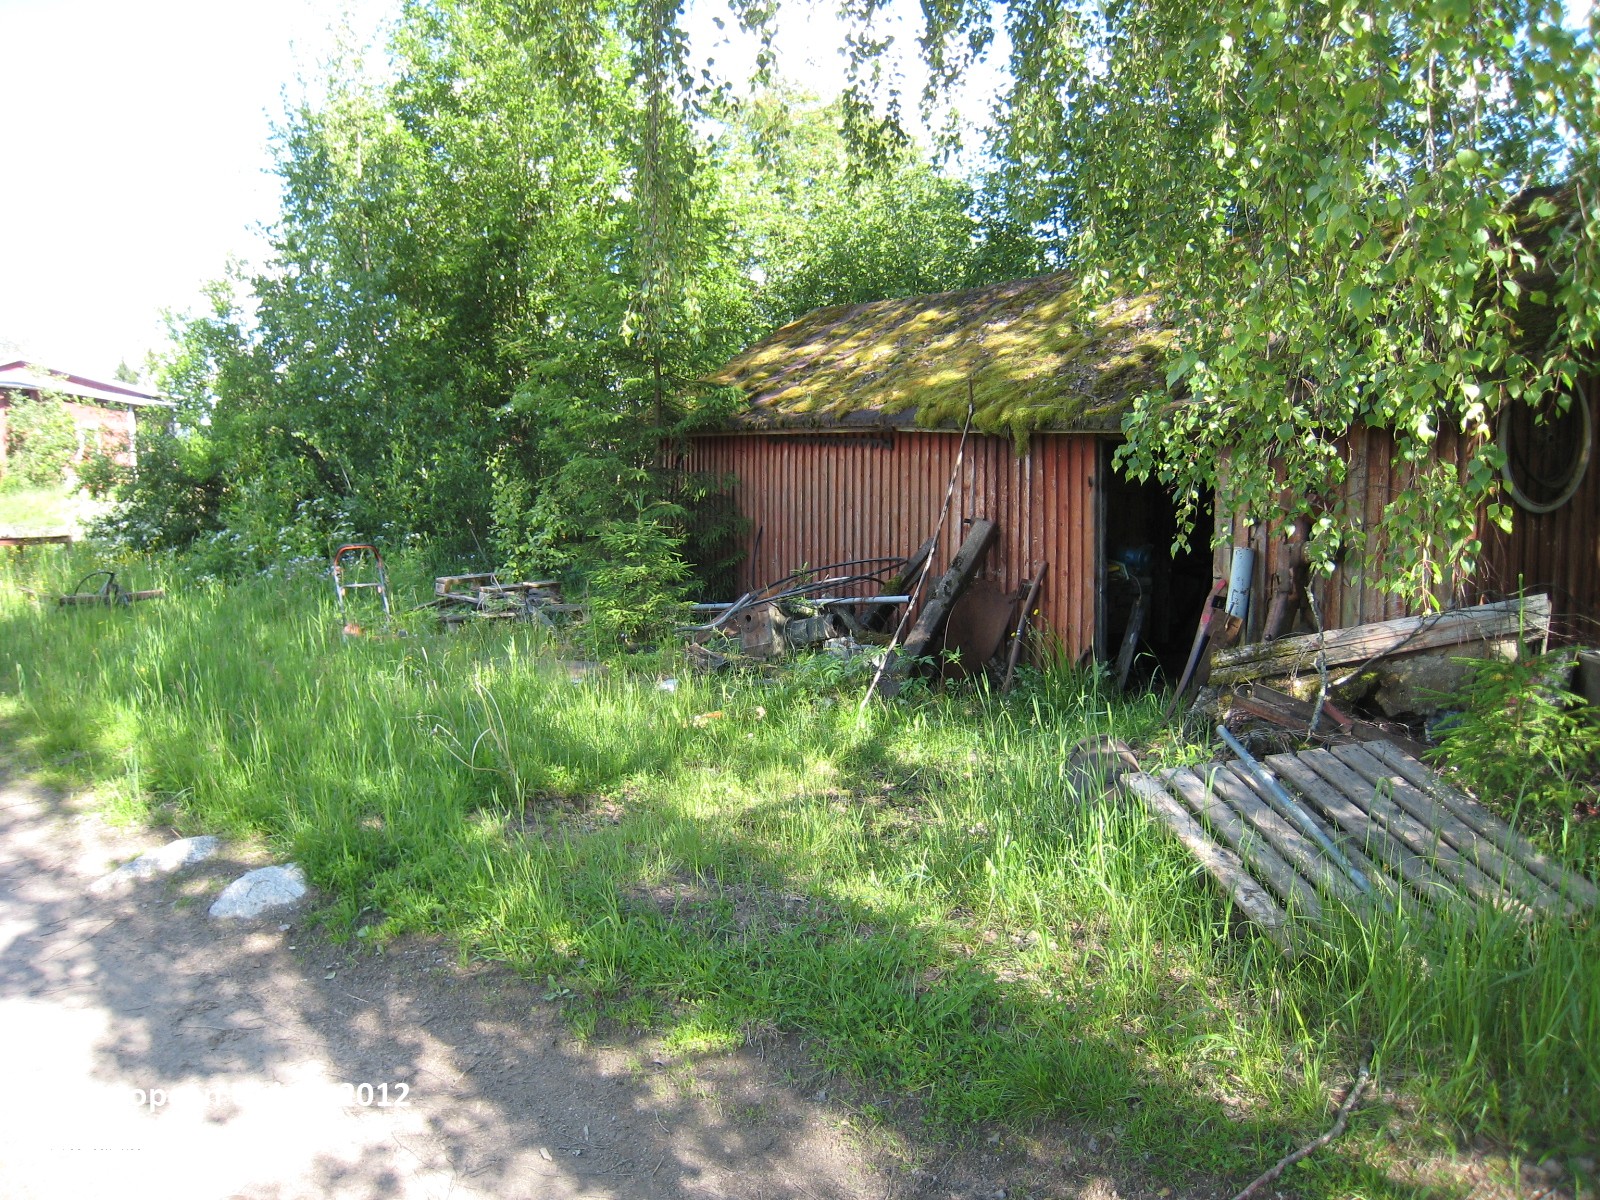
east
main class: Grassland
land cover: Grassland without tree/shrub cover
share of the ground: > 75 %
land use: Agriculture (excluding fallow land and kitchen gardens)
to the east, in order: Grassland without tree/shrub cover; Fences; Shruby margins; Artificial constructions in urban areas; Grassland without tree/shrub cover; Single bushes/trees; Grassland with sparse tree/shrub cover; Tracks; Ditches and canals; Fences; Other bare soil; Grassland without tree/shrub cover; Other bare soil; Grassland without tree/shrub cover; Fences; Spruce dominated coniferous woodland; Dry stone walls; Spruce dominated coniferous woodland; Ditches and canals; Tracks; Shruby margins
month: June
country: FI
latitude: 62.4832
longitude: 26.3734
